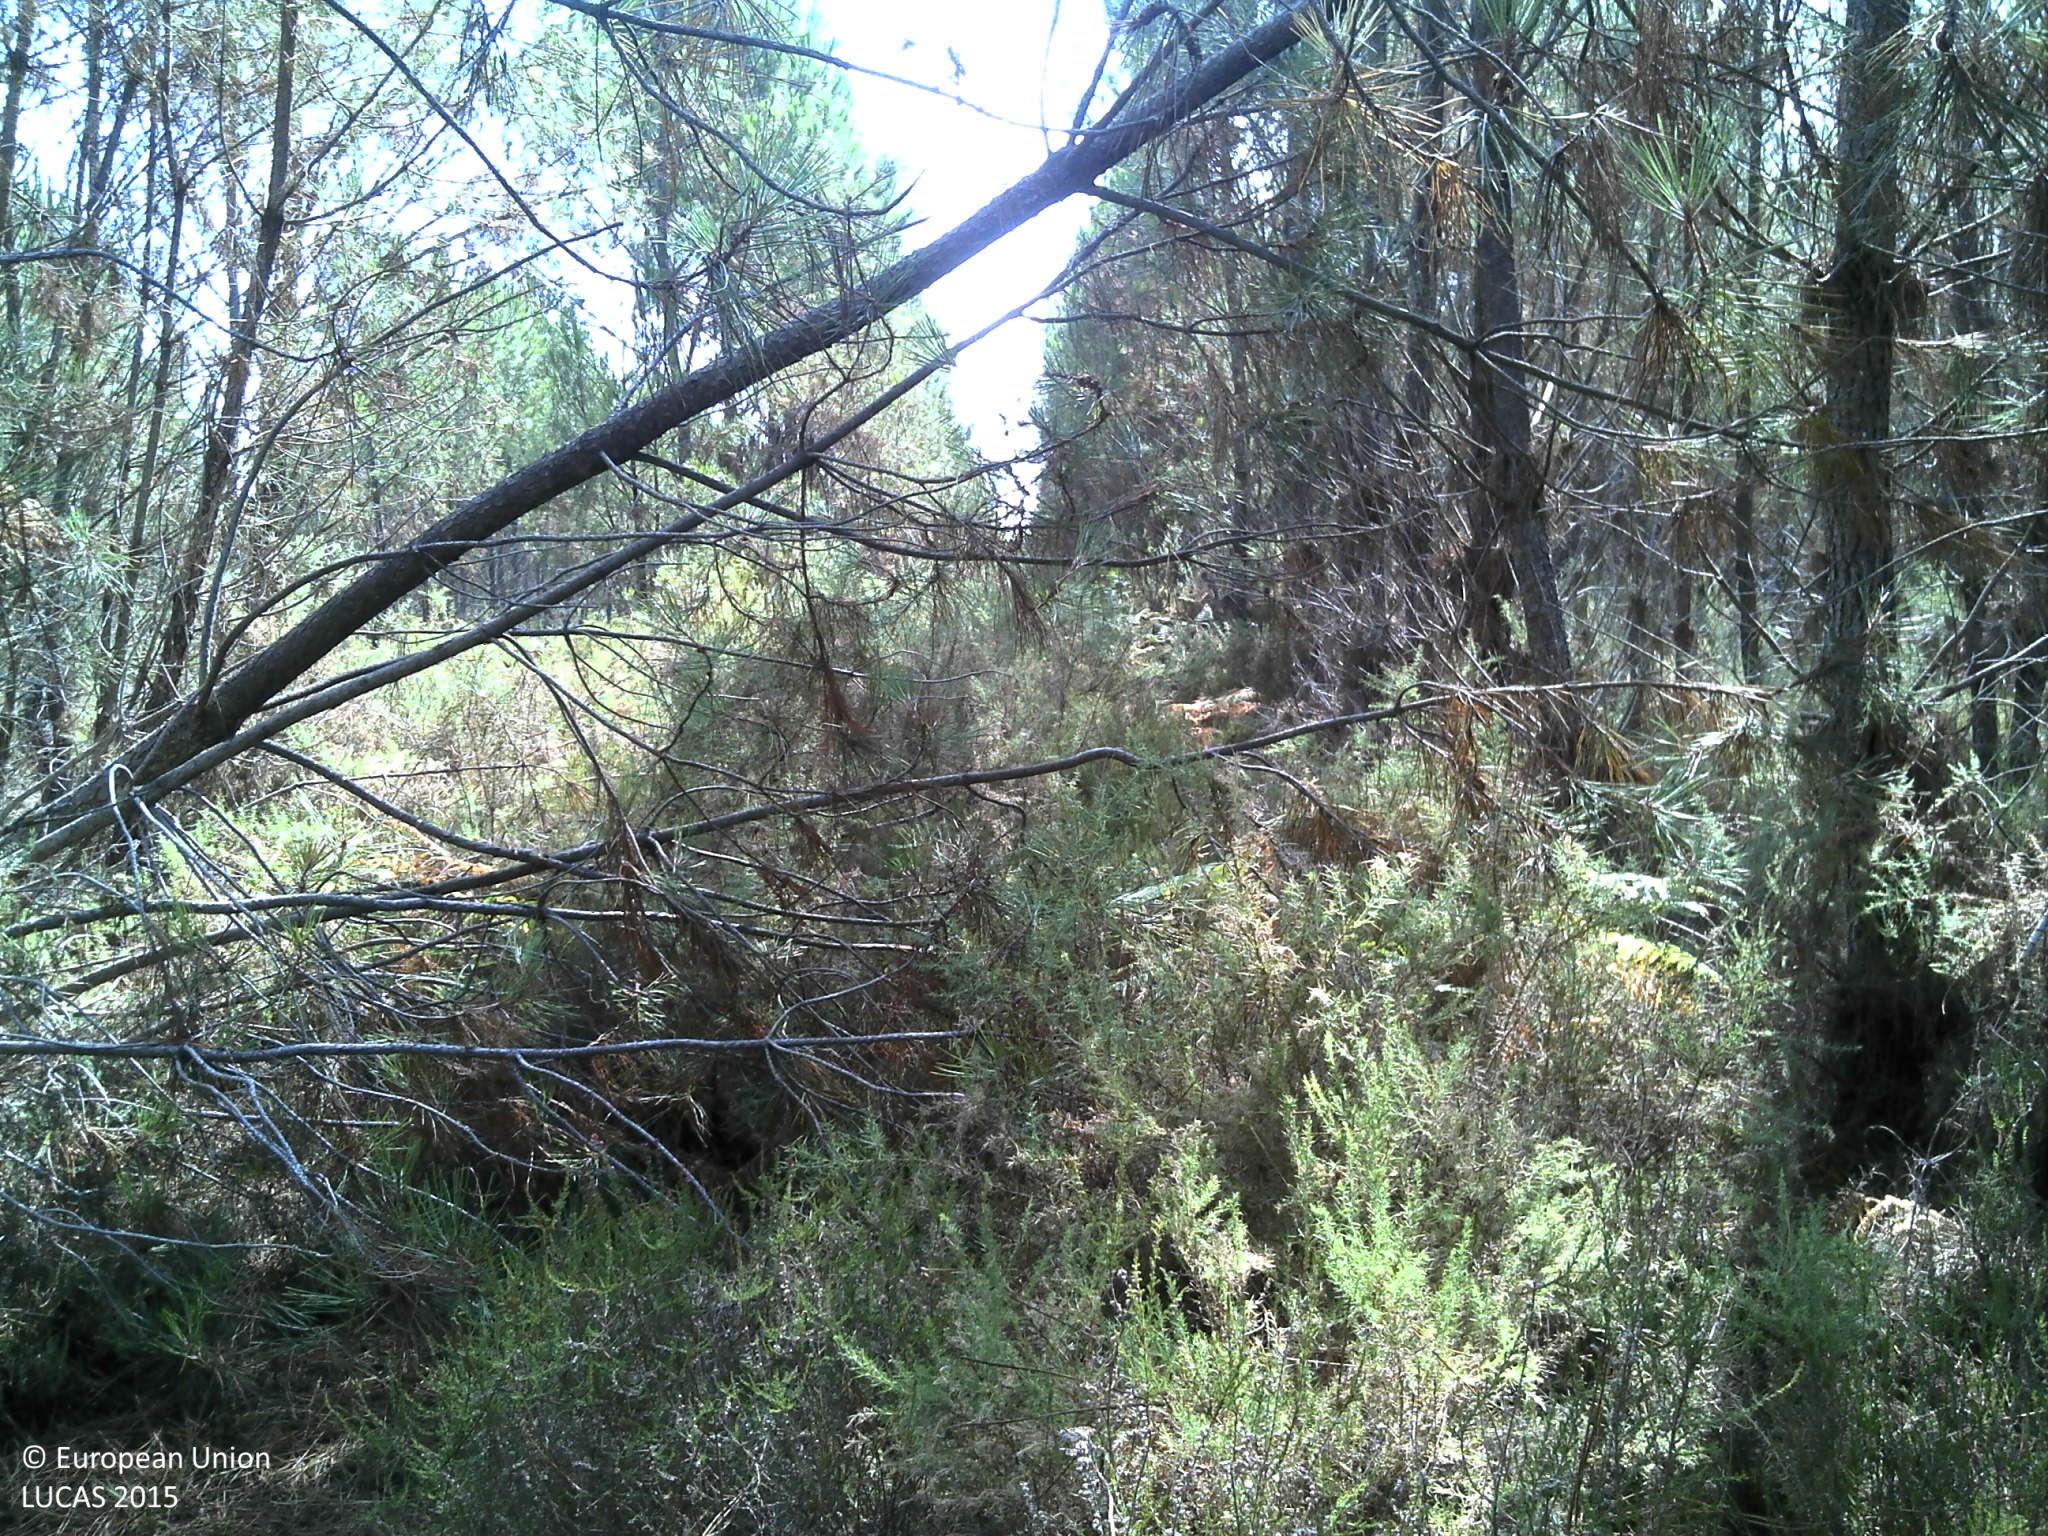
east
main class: Woodland
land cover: Pine dominated coniferous woodland
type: coniferous forest of the mediterranean region
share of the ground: > 75 %
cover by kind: coniferous forest trees 60 %, shrubs 30 %, herbaceous plants 5 %, lichens and mosses 5 %
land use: Forestry
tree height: > 5 m
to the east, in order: Pine dominated coniferous woodland; Tracks; Pine dominated coniferous woodland
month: July
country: FR
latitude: 44.4134
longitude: -0.5269
